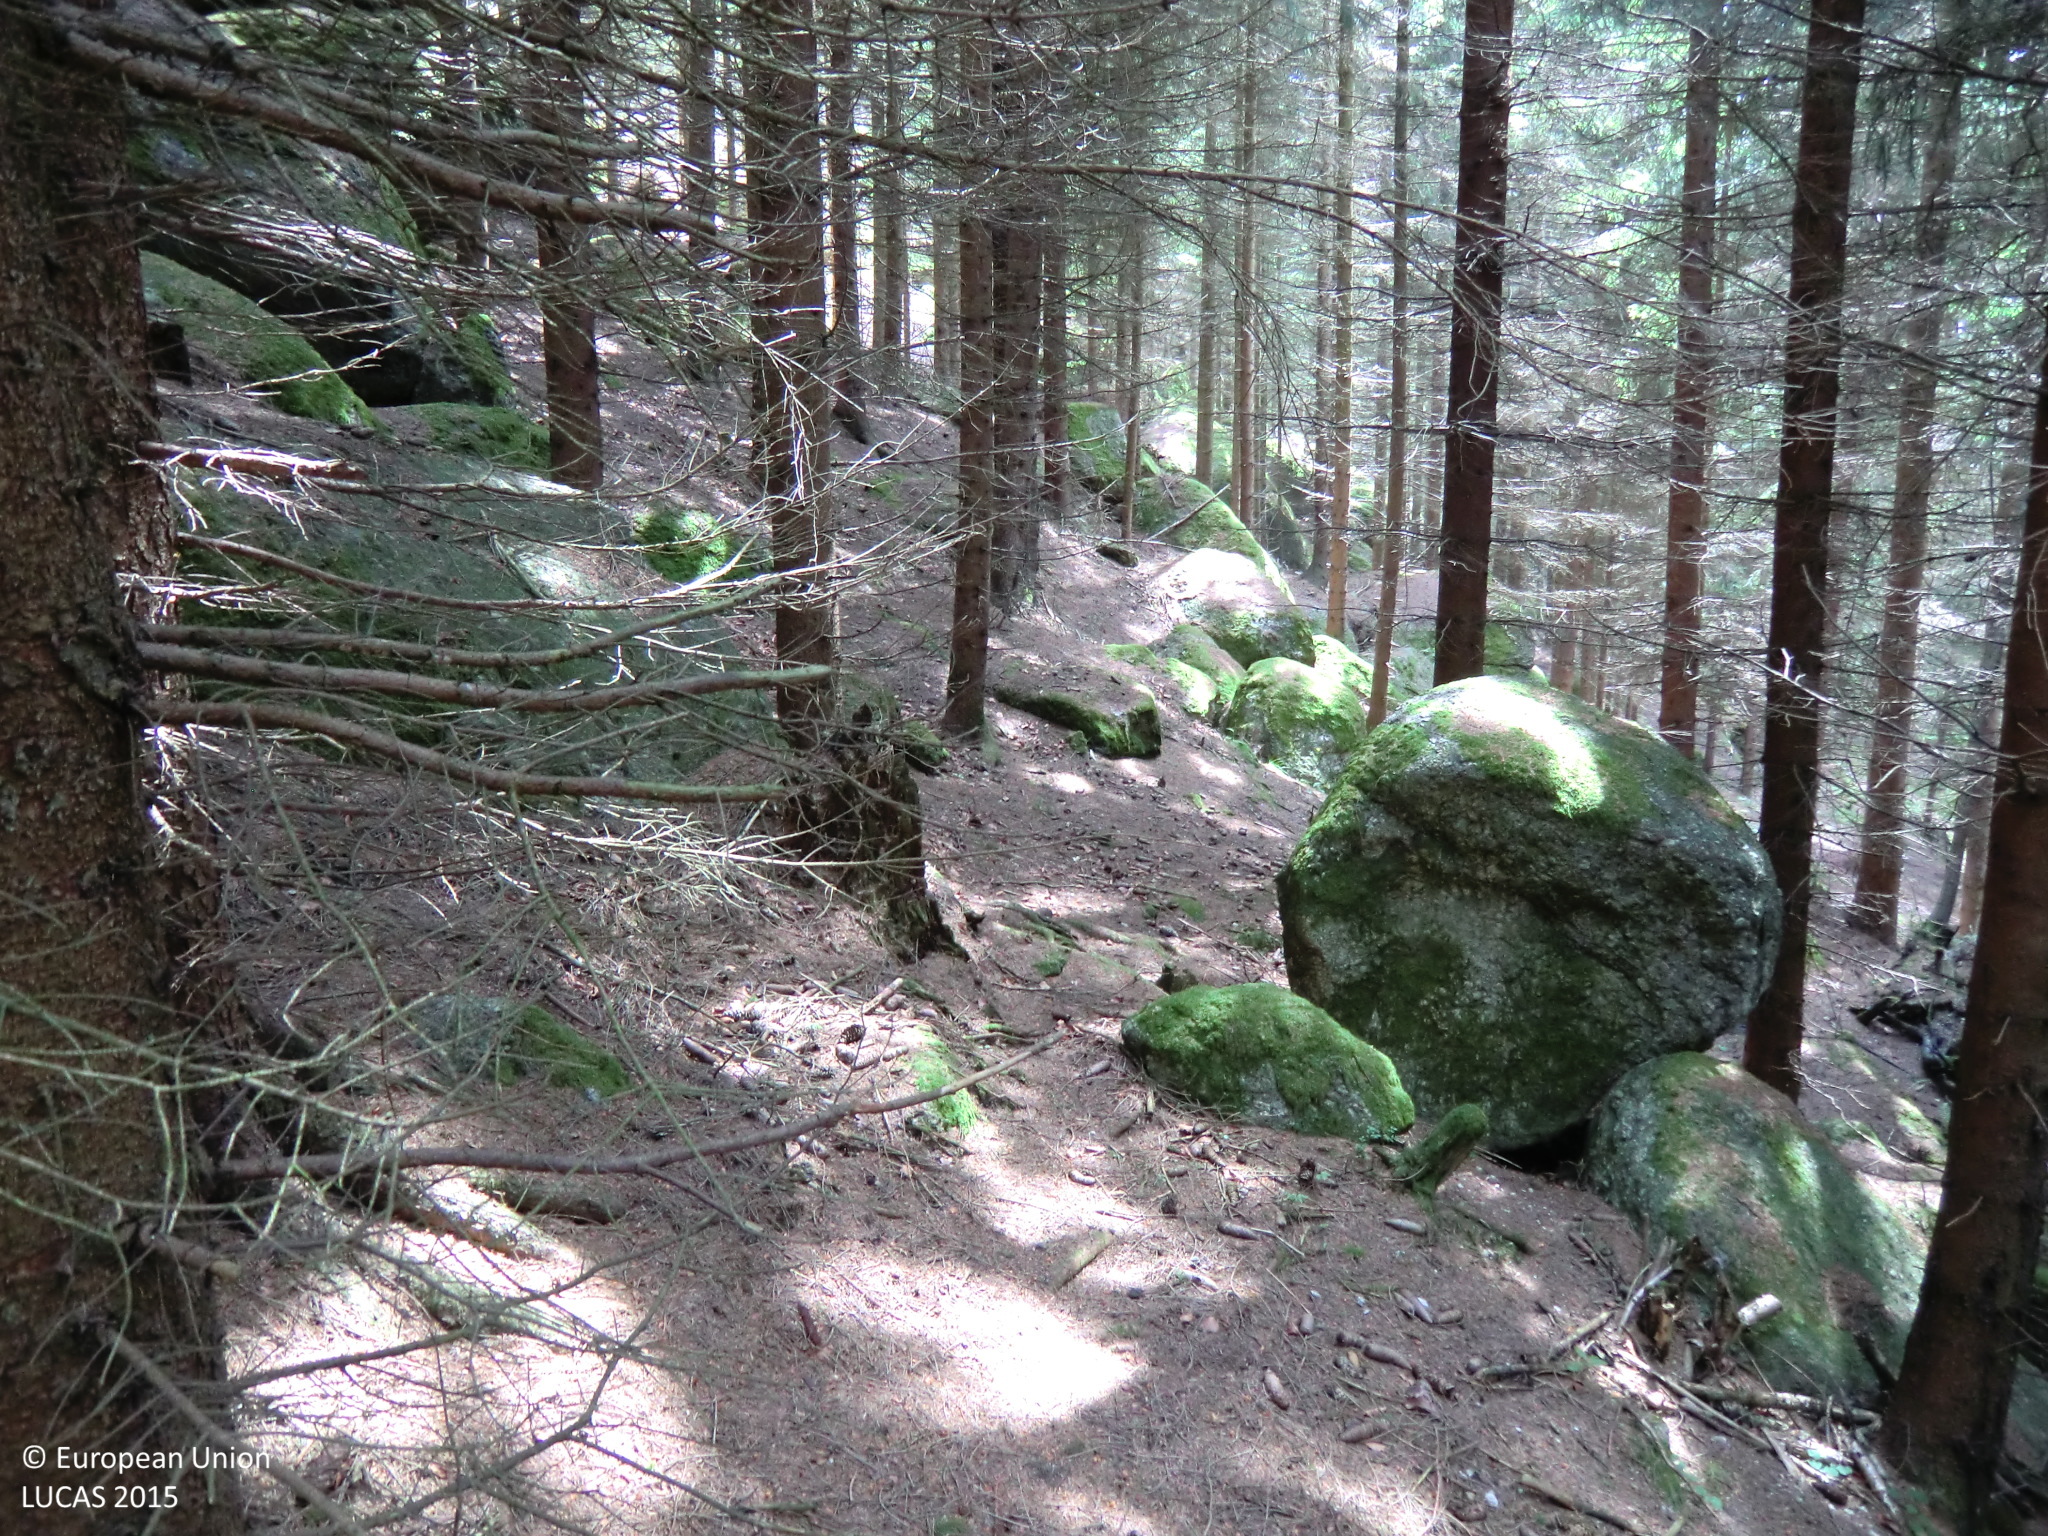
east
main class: Woodland
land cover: Spruce dominated coniferous woodland
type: hemiboreal forest and nemoral coniferous forest and mixed broadleaved-coniferous forest
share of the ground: > 75 %
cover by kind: coniferous forest trees 90 %, unconsolidated bare surface 10 %
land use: Forestry
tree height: > 5 m
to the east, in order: Spruce dominated coniferous woodland; Tracks; Spruce dominated coniferous woodland; Spruce dominated mixed woodland; Tracks; Shrubland with sparse tree cover; Spruce dominated coniferous woodland
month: June
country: AT
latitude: 48.4255
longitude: 14.7986
